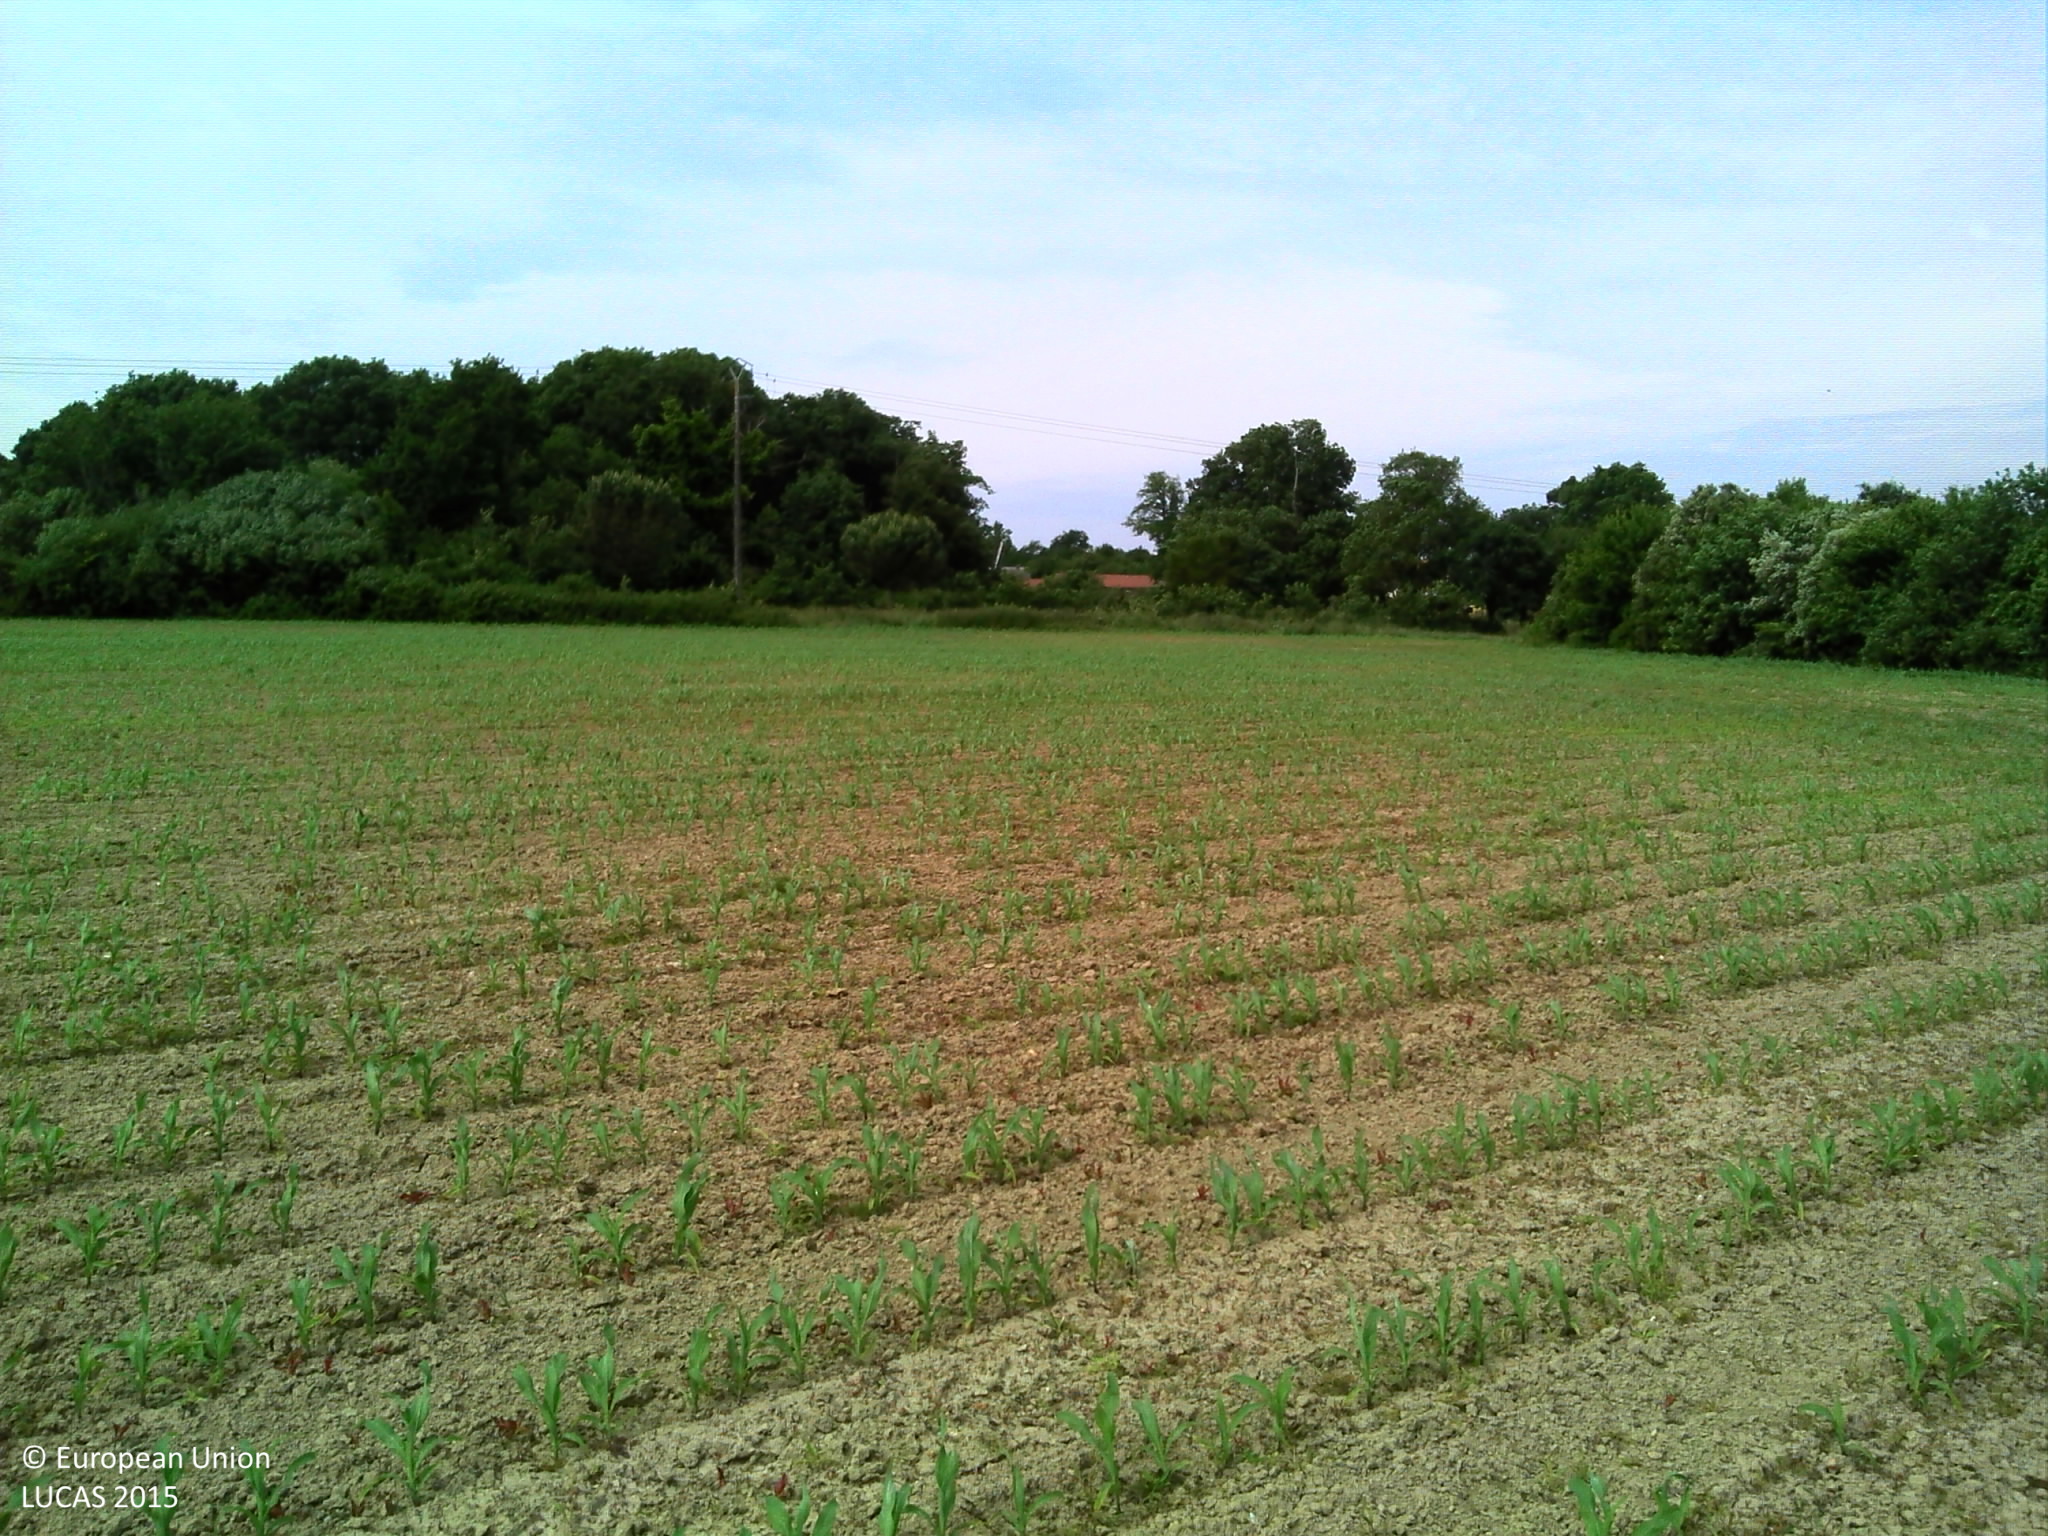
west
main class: Cropland
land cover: Maize
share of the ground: 10 - 25 %
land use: Agriculture (excluding fallow land and kitchen gardens)
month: June
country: FR
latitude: 47.1047
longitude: -2.0524
